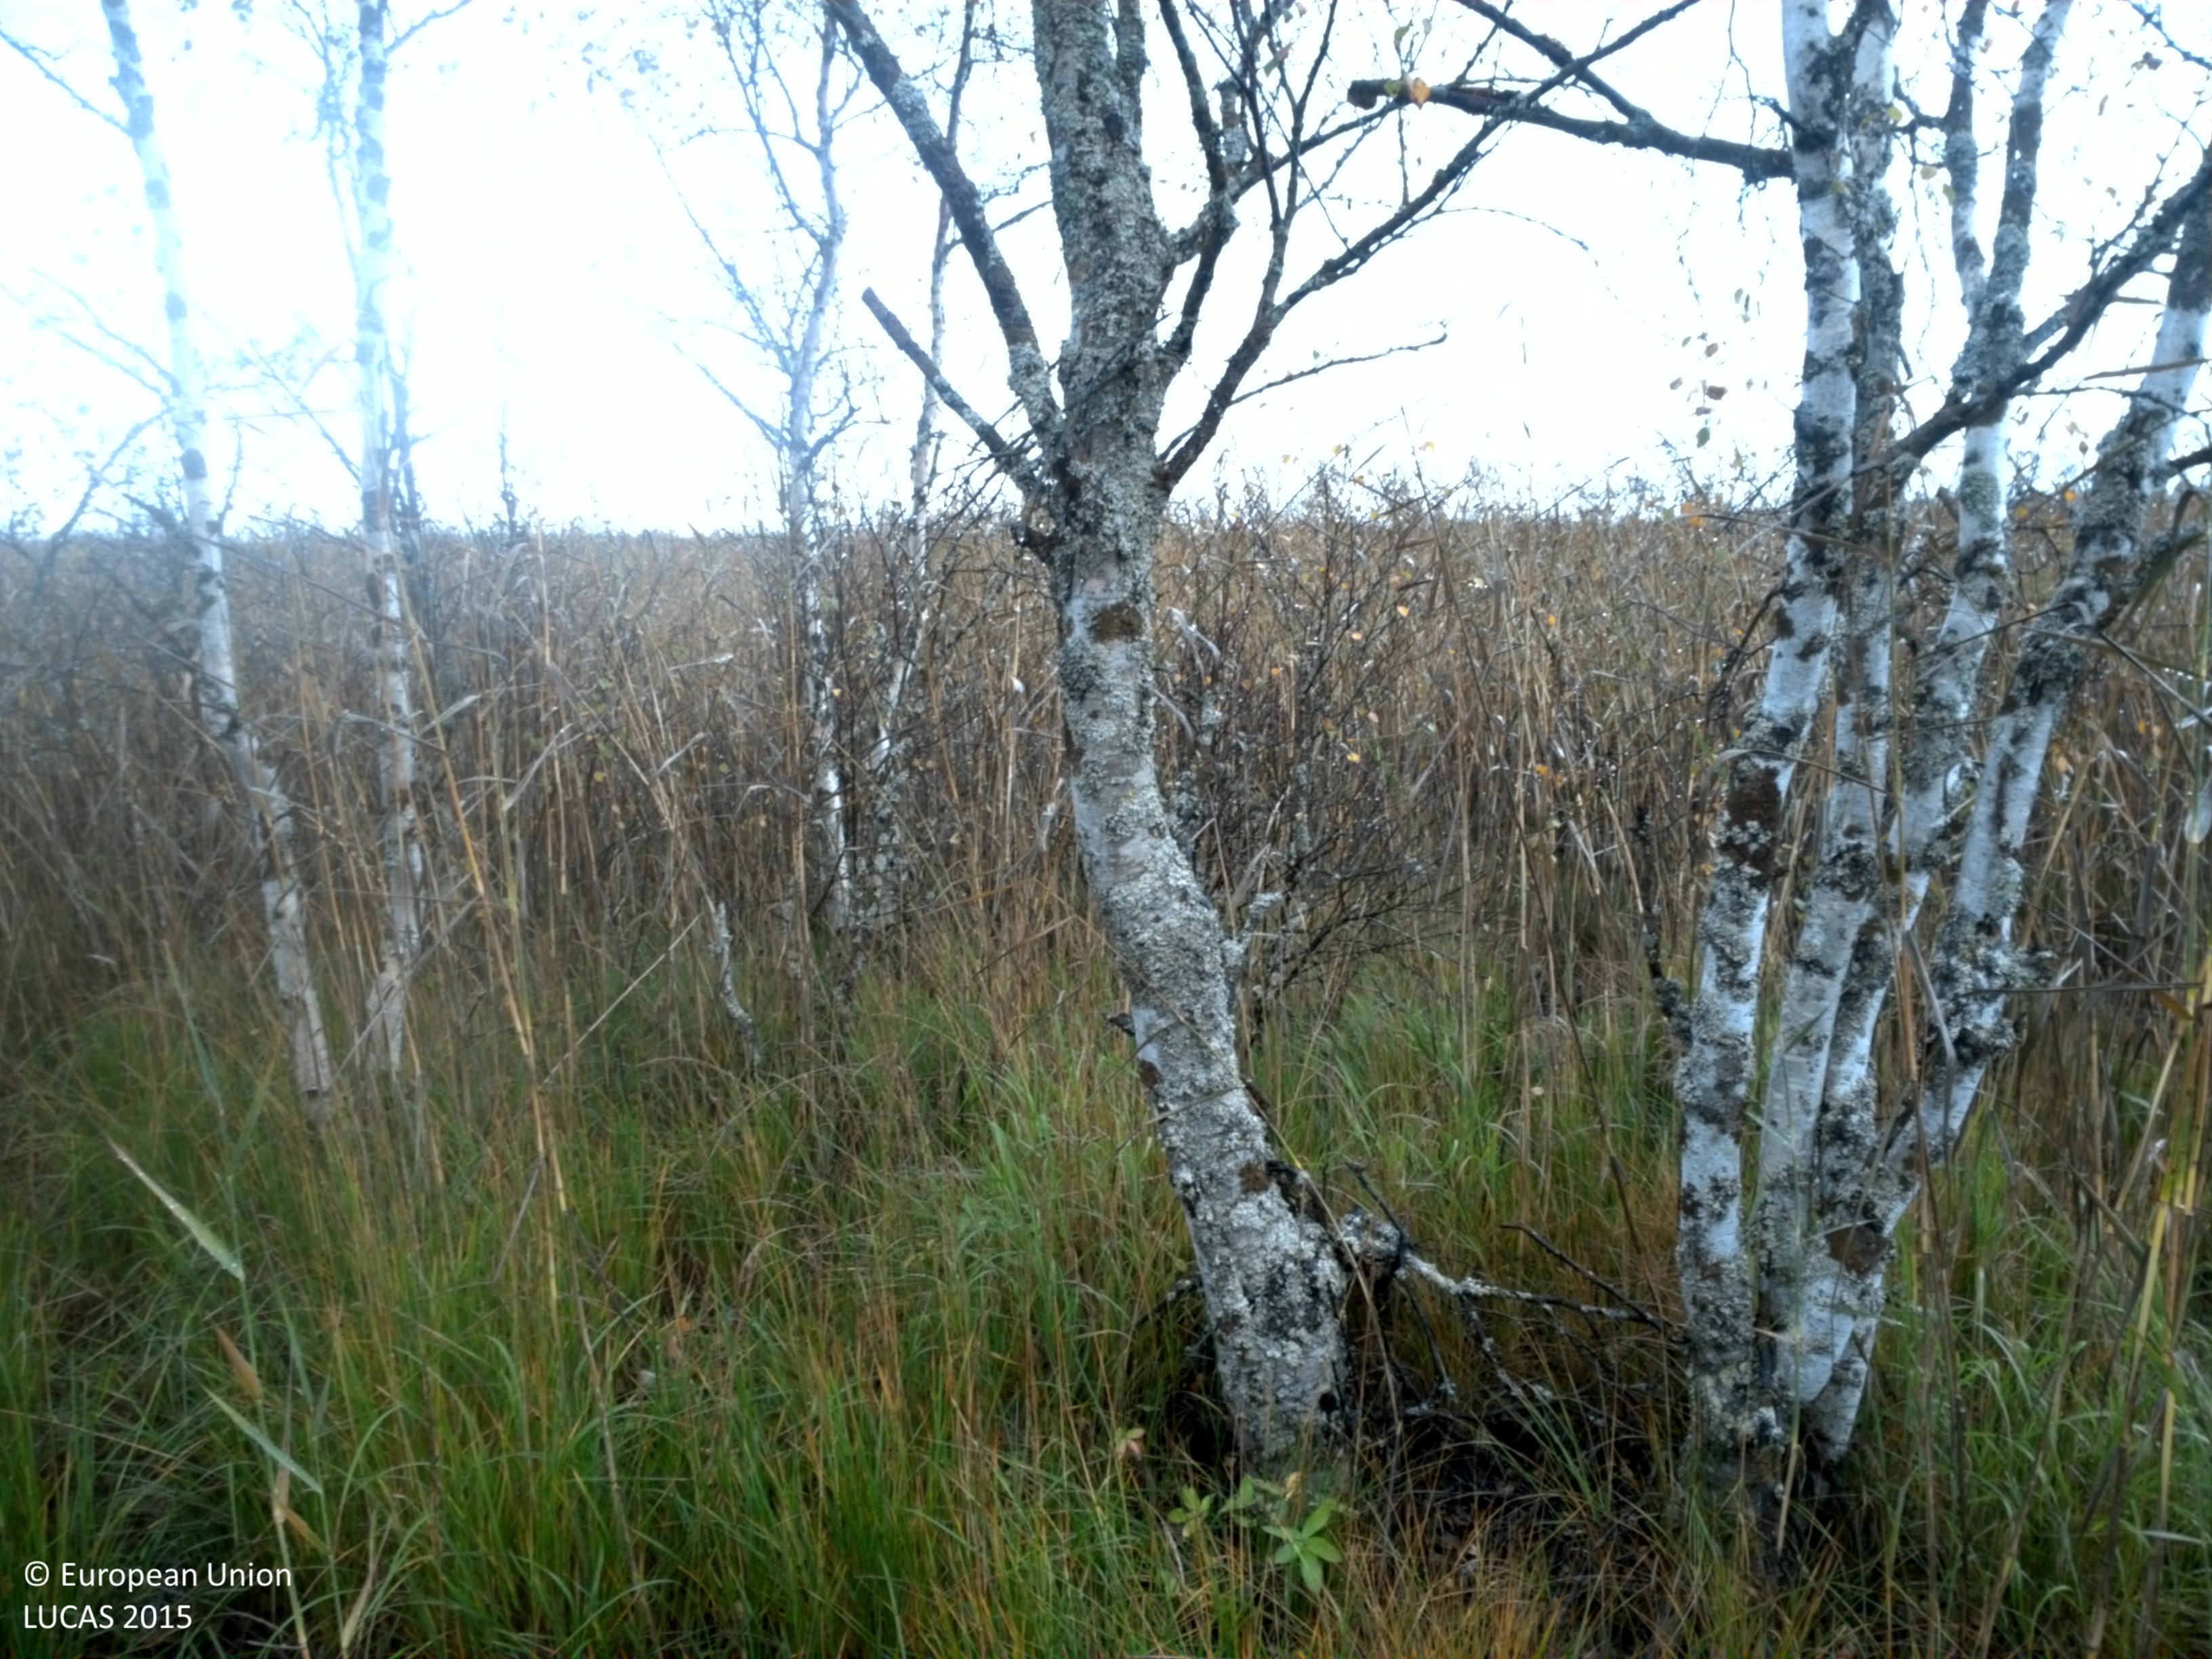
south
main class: Woodland
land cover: Broadleaved woodland
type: mire and swamp forests
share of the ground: 50 - 75 %
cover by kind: broadleaved forest trees 55 %, herbaceous plants 35 %
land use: Semi-natural and natural areas not in use
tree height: > 5 m
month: September
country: SE
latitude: 65.6393
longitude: 22.0801
